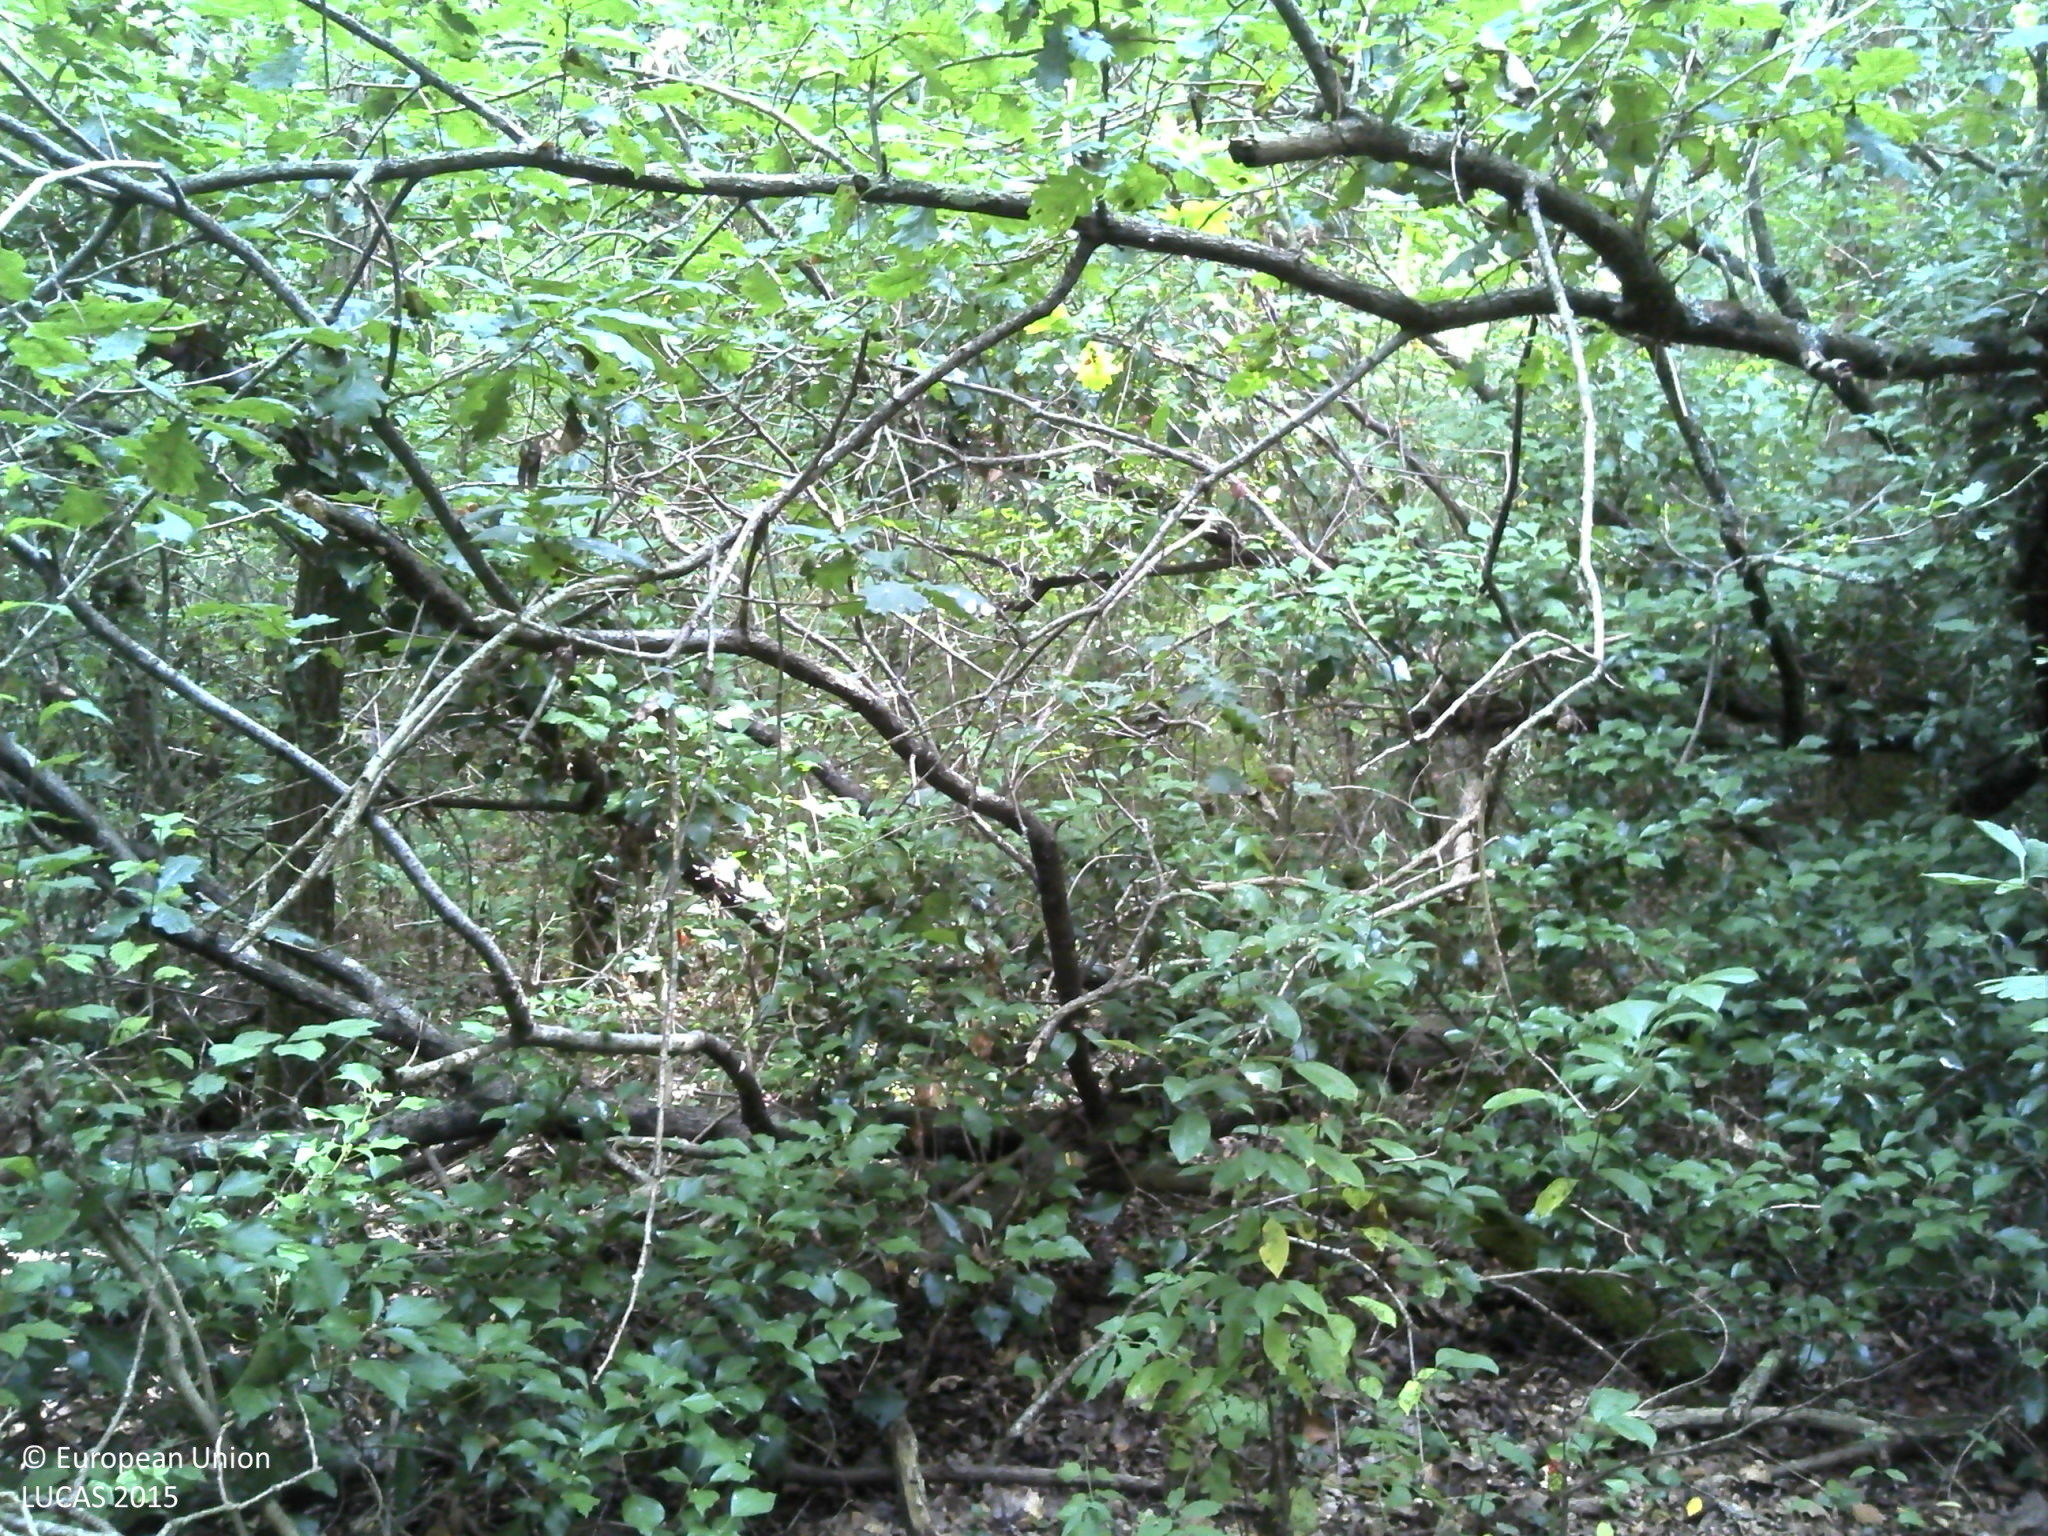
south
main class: Woodland
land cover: Broadleaved woodland
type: acidophilous oak and oak-birch forest
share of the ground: > 75 %
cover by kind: broadleaved forest trees 60 %, shrubs 30 %, herbaceous plants 5 %, lichens and mosses 5 %
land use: Forestry
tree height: > 5 m
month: July
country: FR
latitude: 44.5534
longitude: -0.4007
